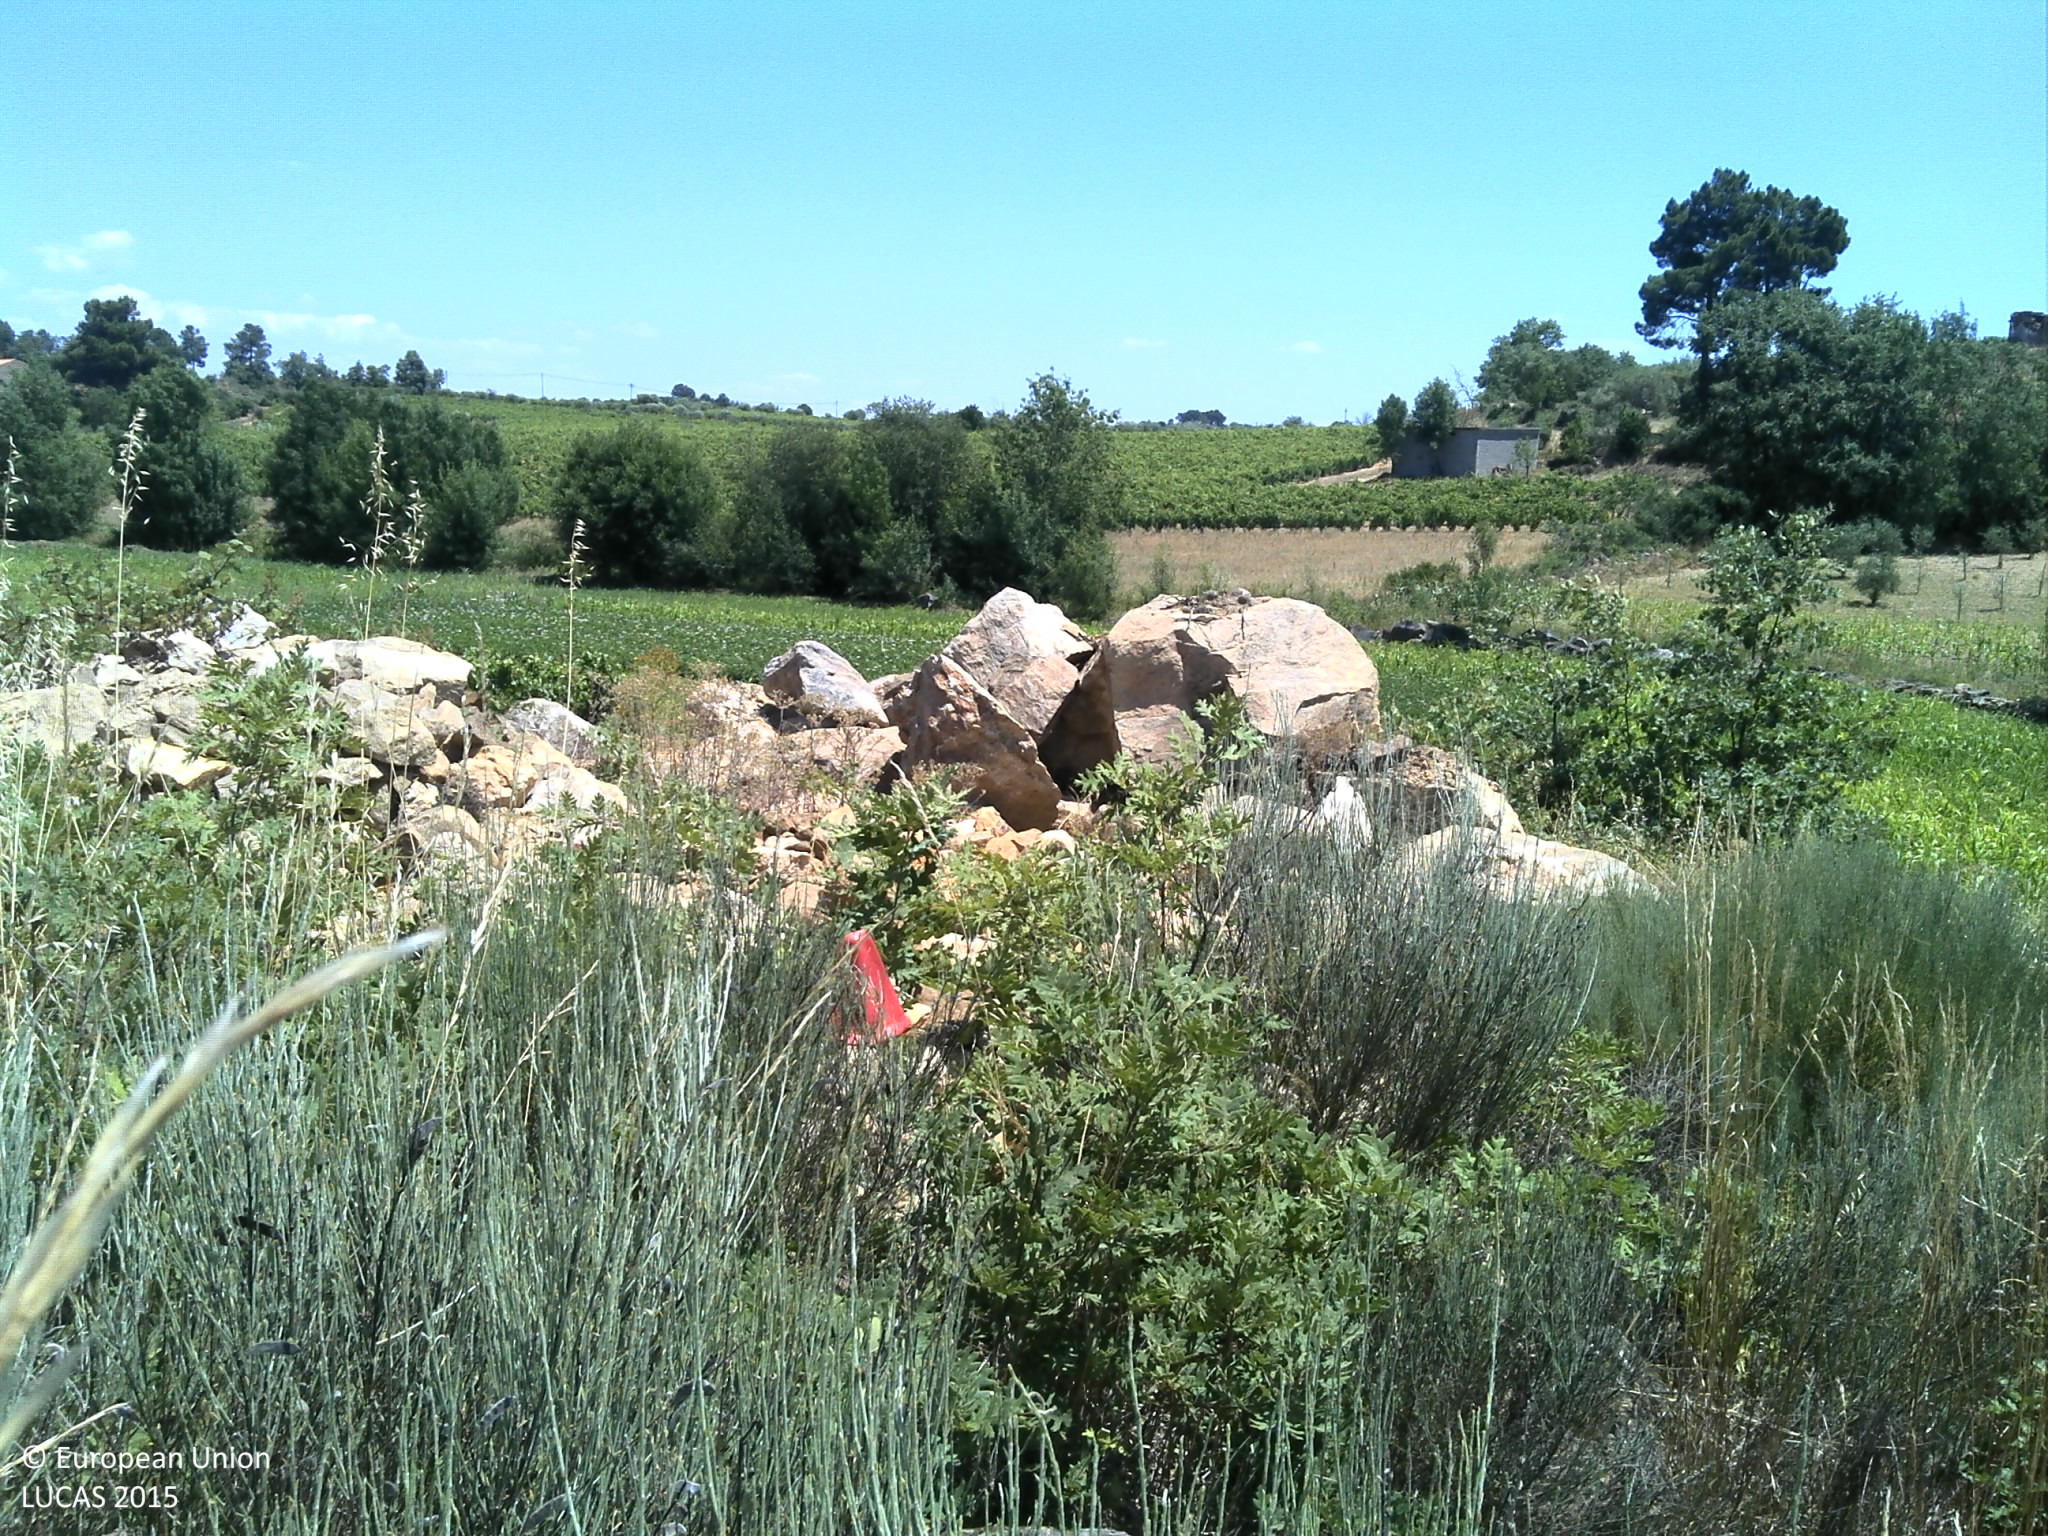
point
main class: Shrubland
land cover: Shrubland without tree cover
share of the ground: 50 - 75 %
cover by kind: shrubs 50 %, consolidated bare surface 30 %, herbaceous plants 10 %, unconsolidated bare surface 10 %
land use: Abandoned areas
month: June
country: PT
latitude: 40.7719
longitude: -7.1559
